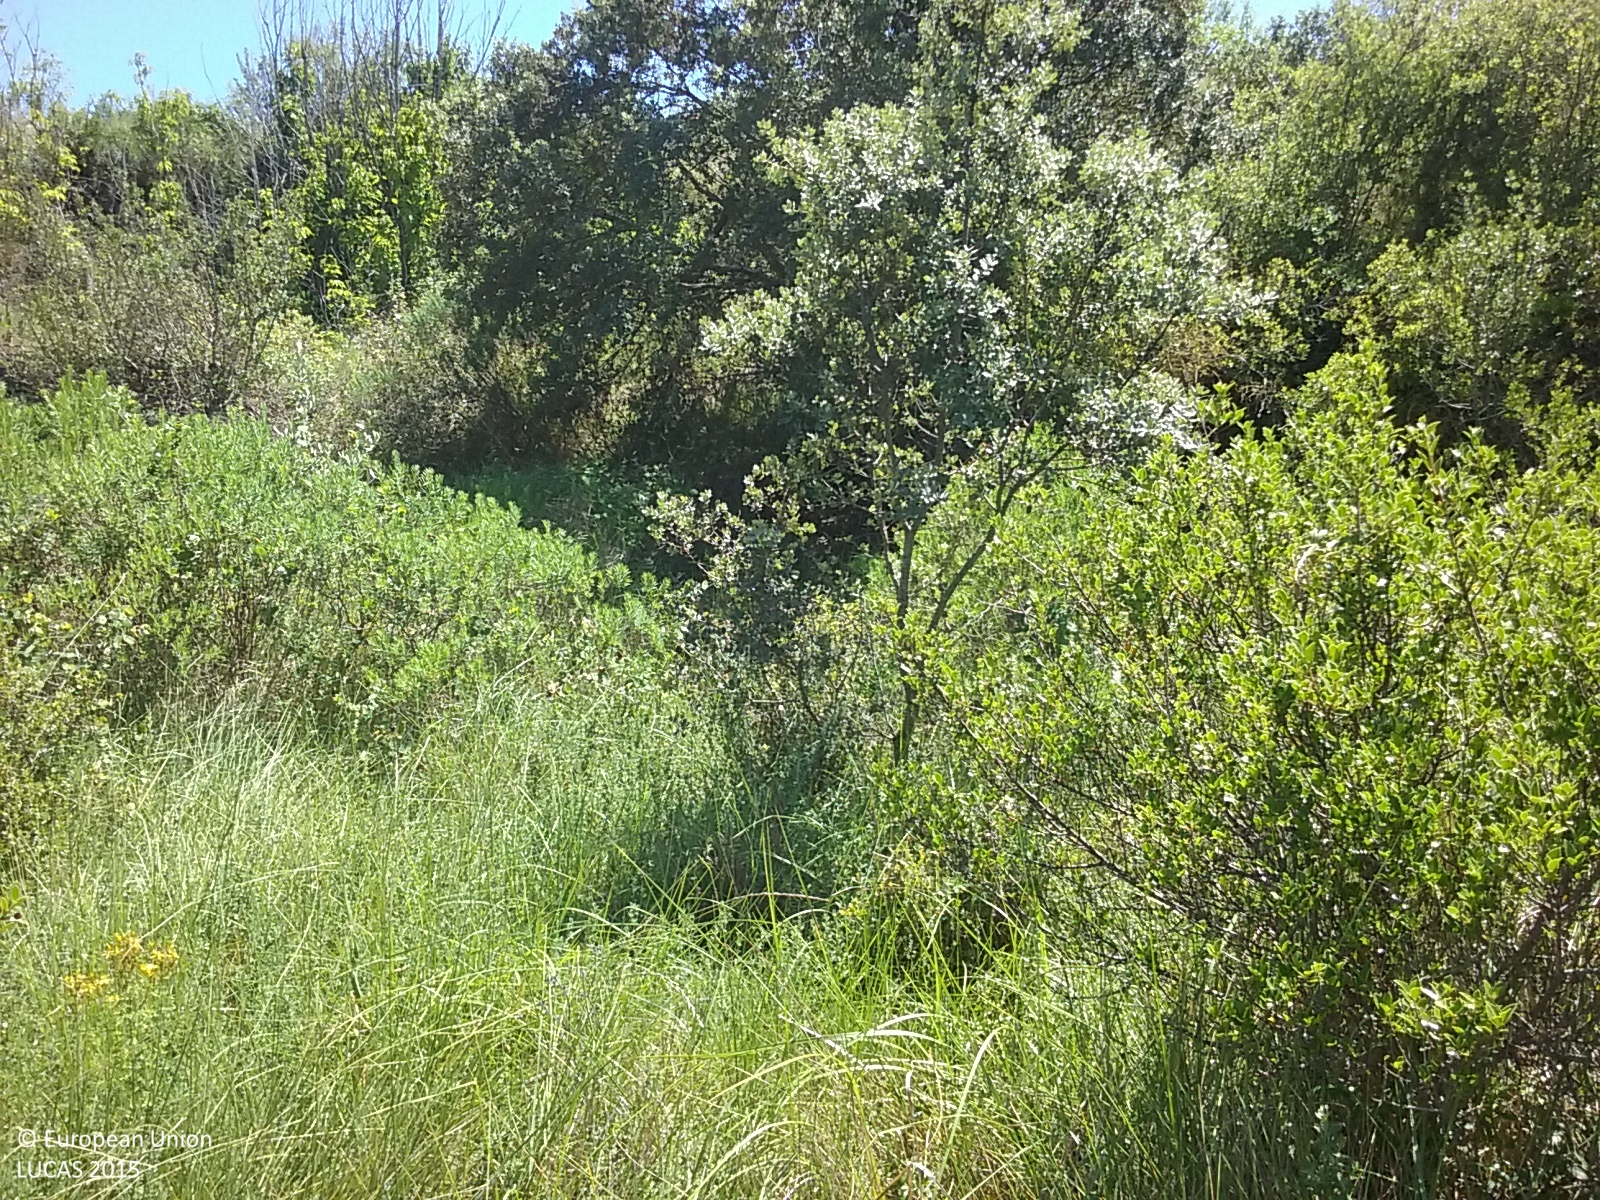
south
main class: Shrubland
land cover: Shrubland with sparse tree cover
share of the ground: 50 - 75 %
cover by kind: herbaceous plants 65 %, shrubs 30 %, broadleaved forest trees 5 %
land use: Semi-natural and natural areas not in use
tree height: < 5 m
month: June
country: ES
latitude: 41.0459
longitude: 0.3428
